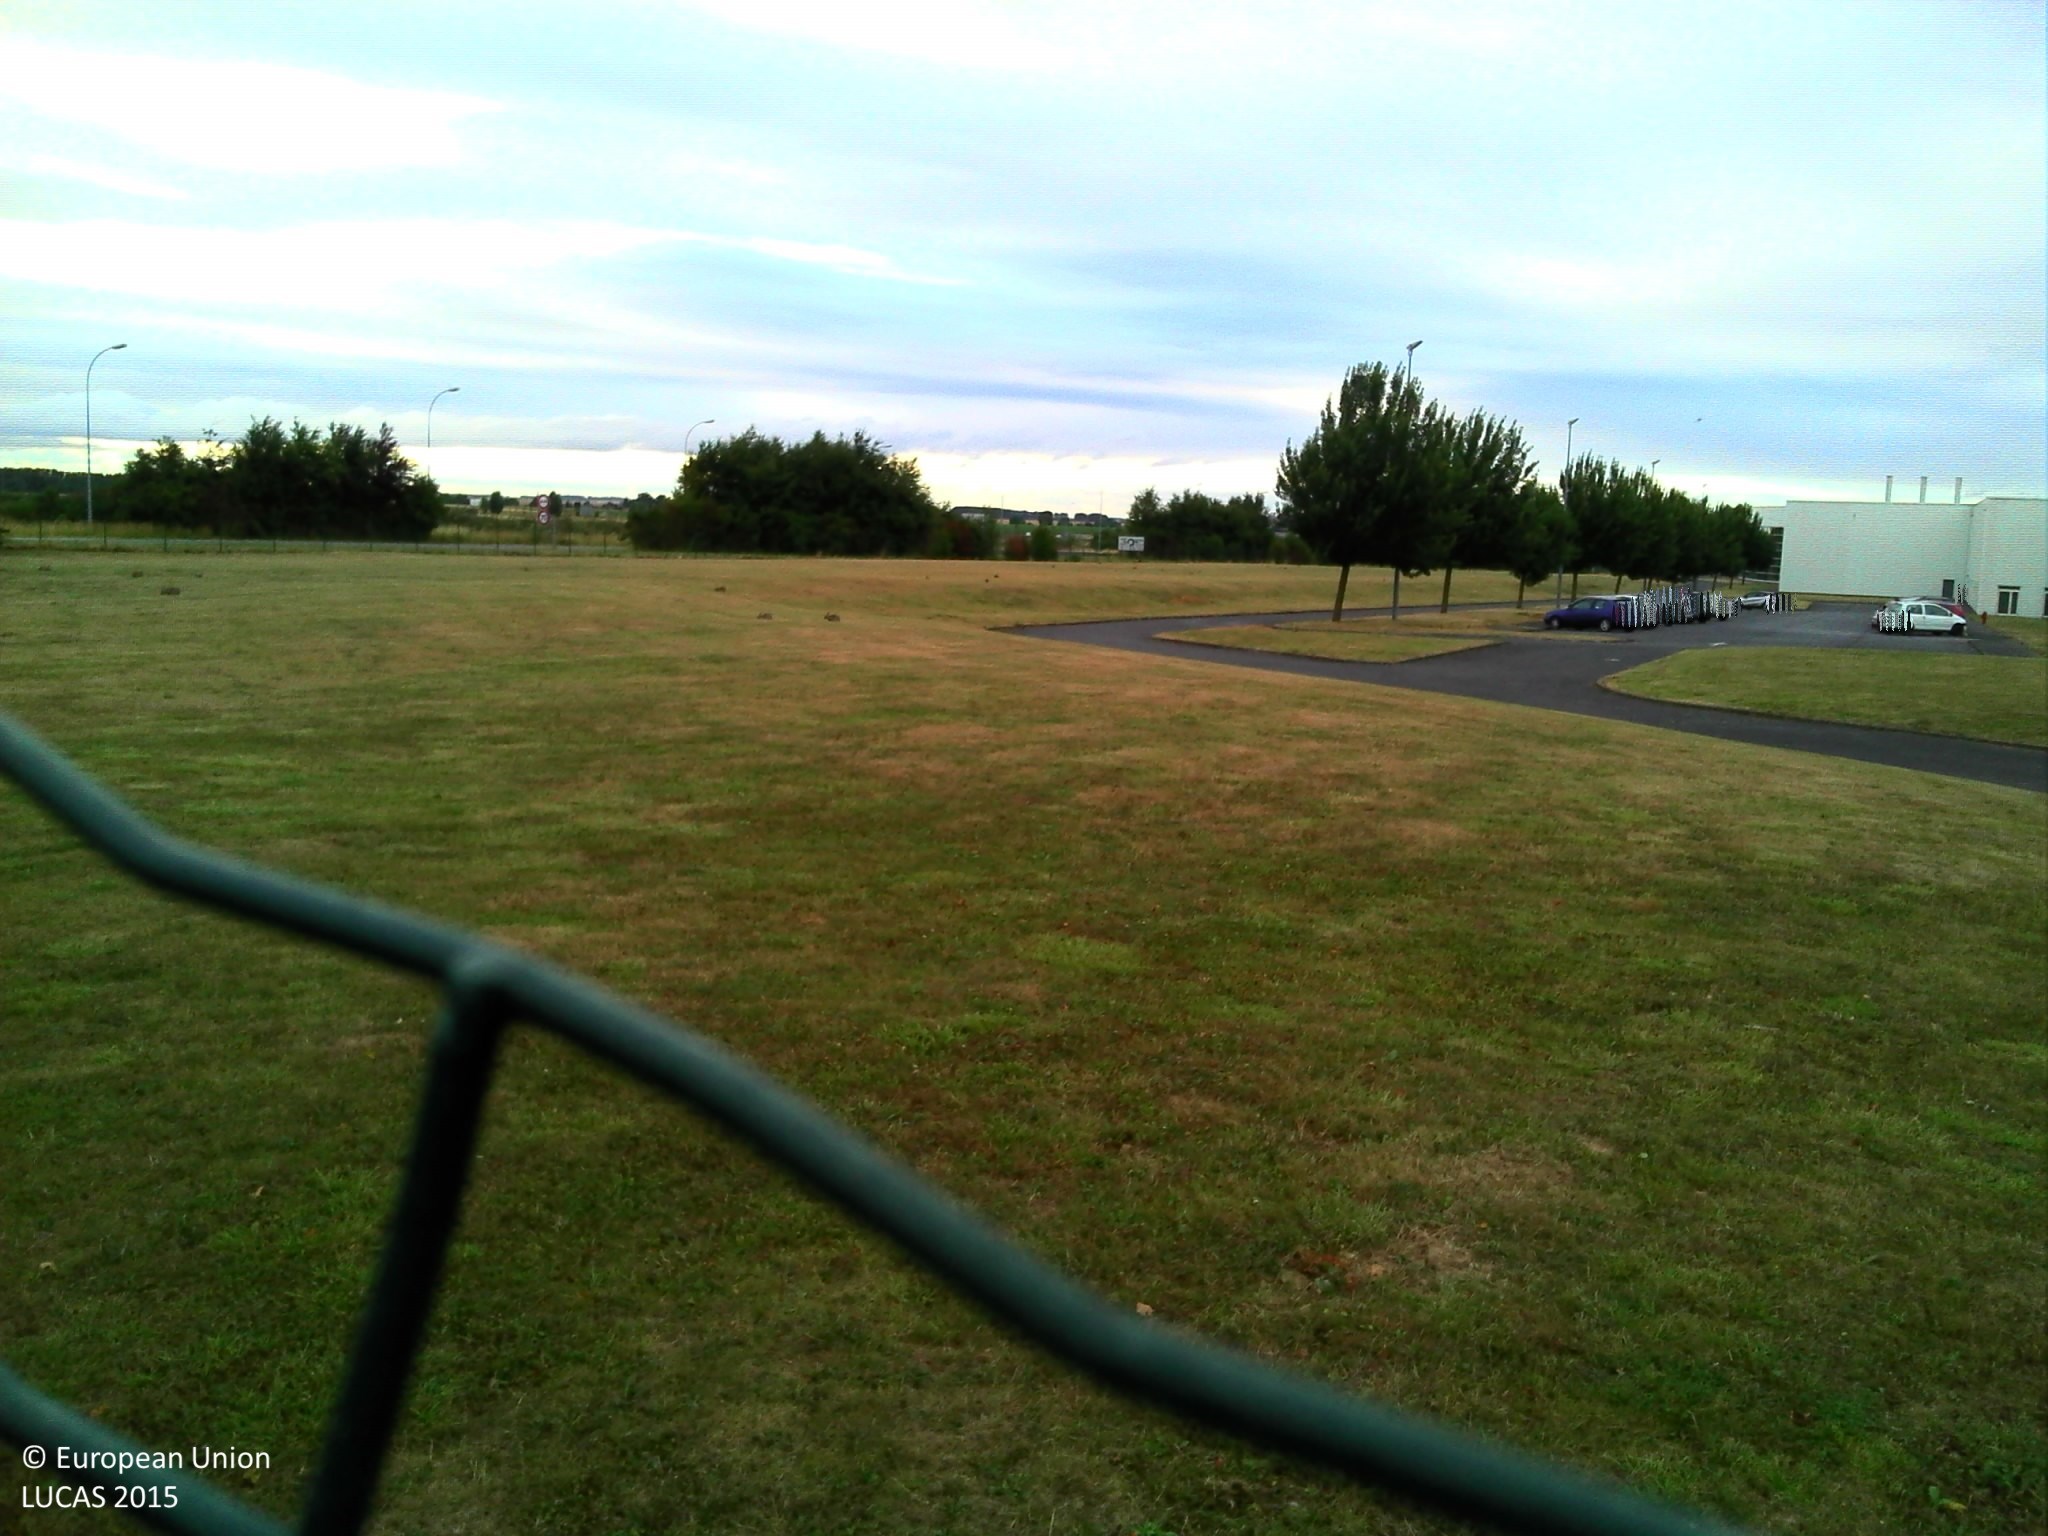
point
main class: Grassland
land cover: Grassland without tree/shrub cover
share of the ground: > 75 %
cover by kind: herbaceous plants 95 %, lichens and mosses 5 %
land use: Machinery and equipment
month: July
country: FR
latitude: 50.1975
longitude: 3.1968
